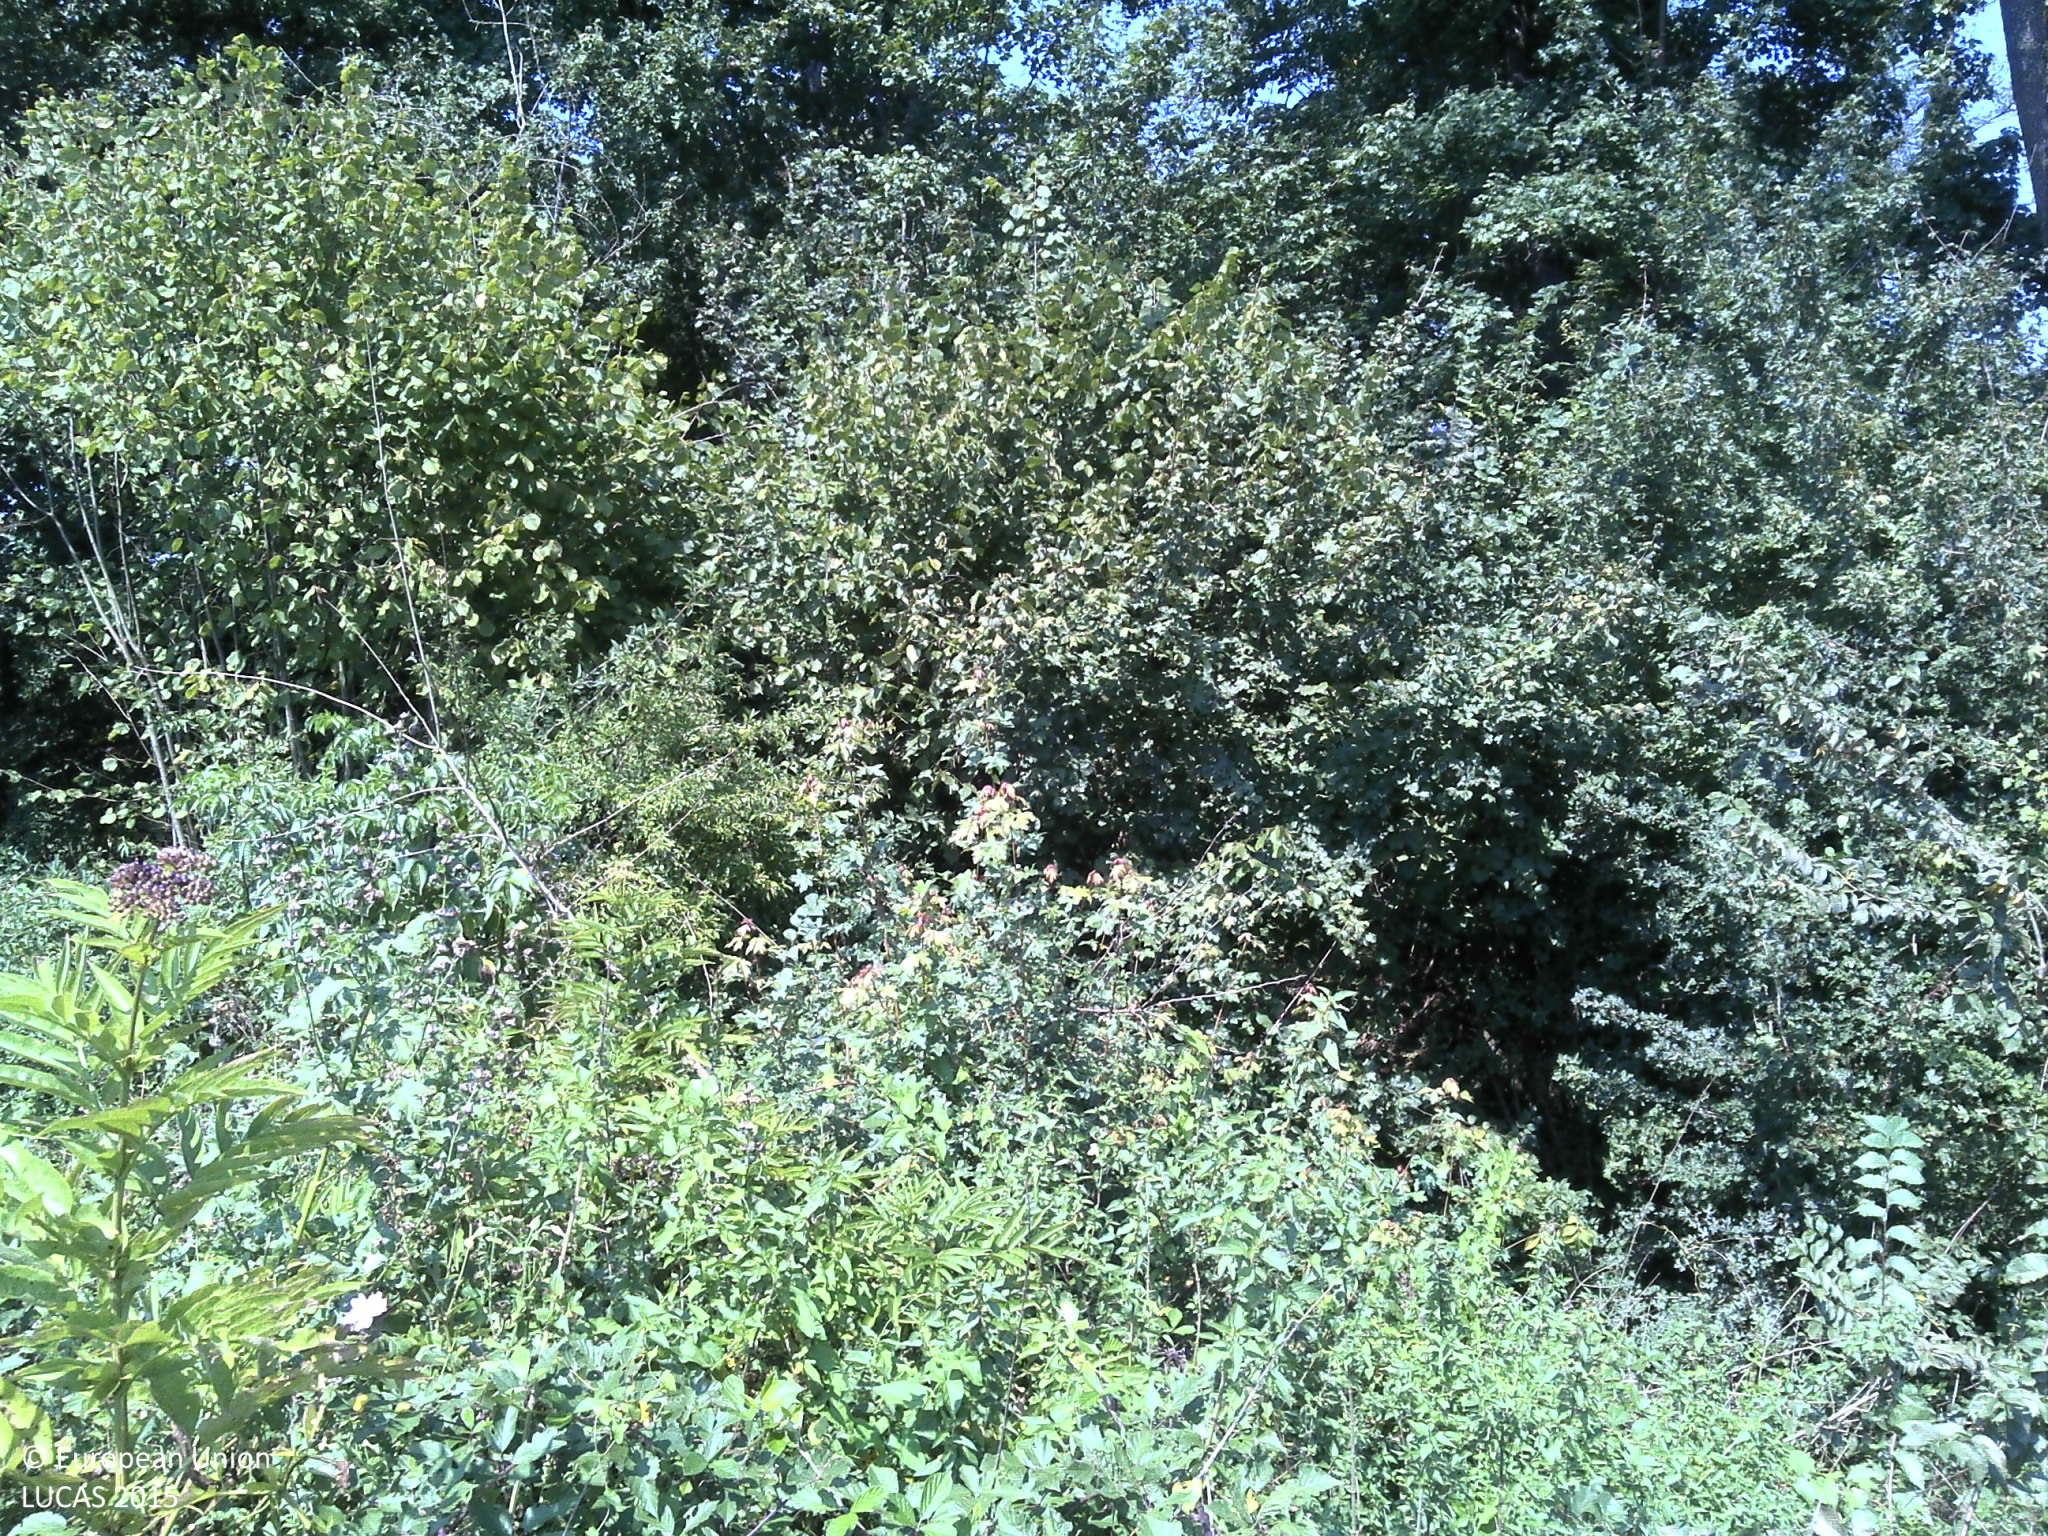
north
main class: Shrubland
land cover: Shrubland with sparse tree cover
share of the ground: > 75 %
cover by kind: shrubs 90 %, broadleaved forest trees 5 %, herbaceous plants 5 %
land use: Semi-natural and natural areas not in use
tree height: < 5 m
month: August
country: HR
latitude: 45.3171
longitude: 16.2860
